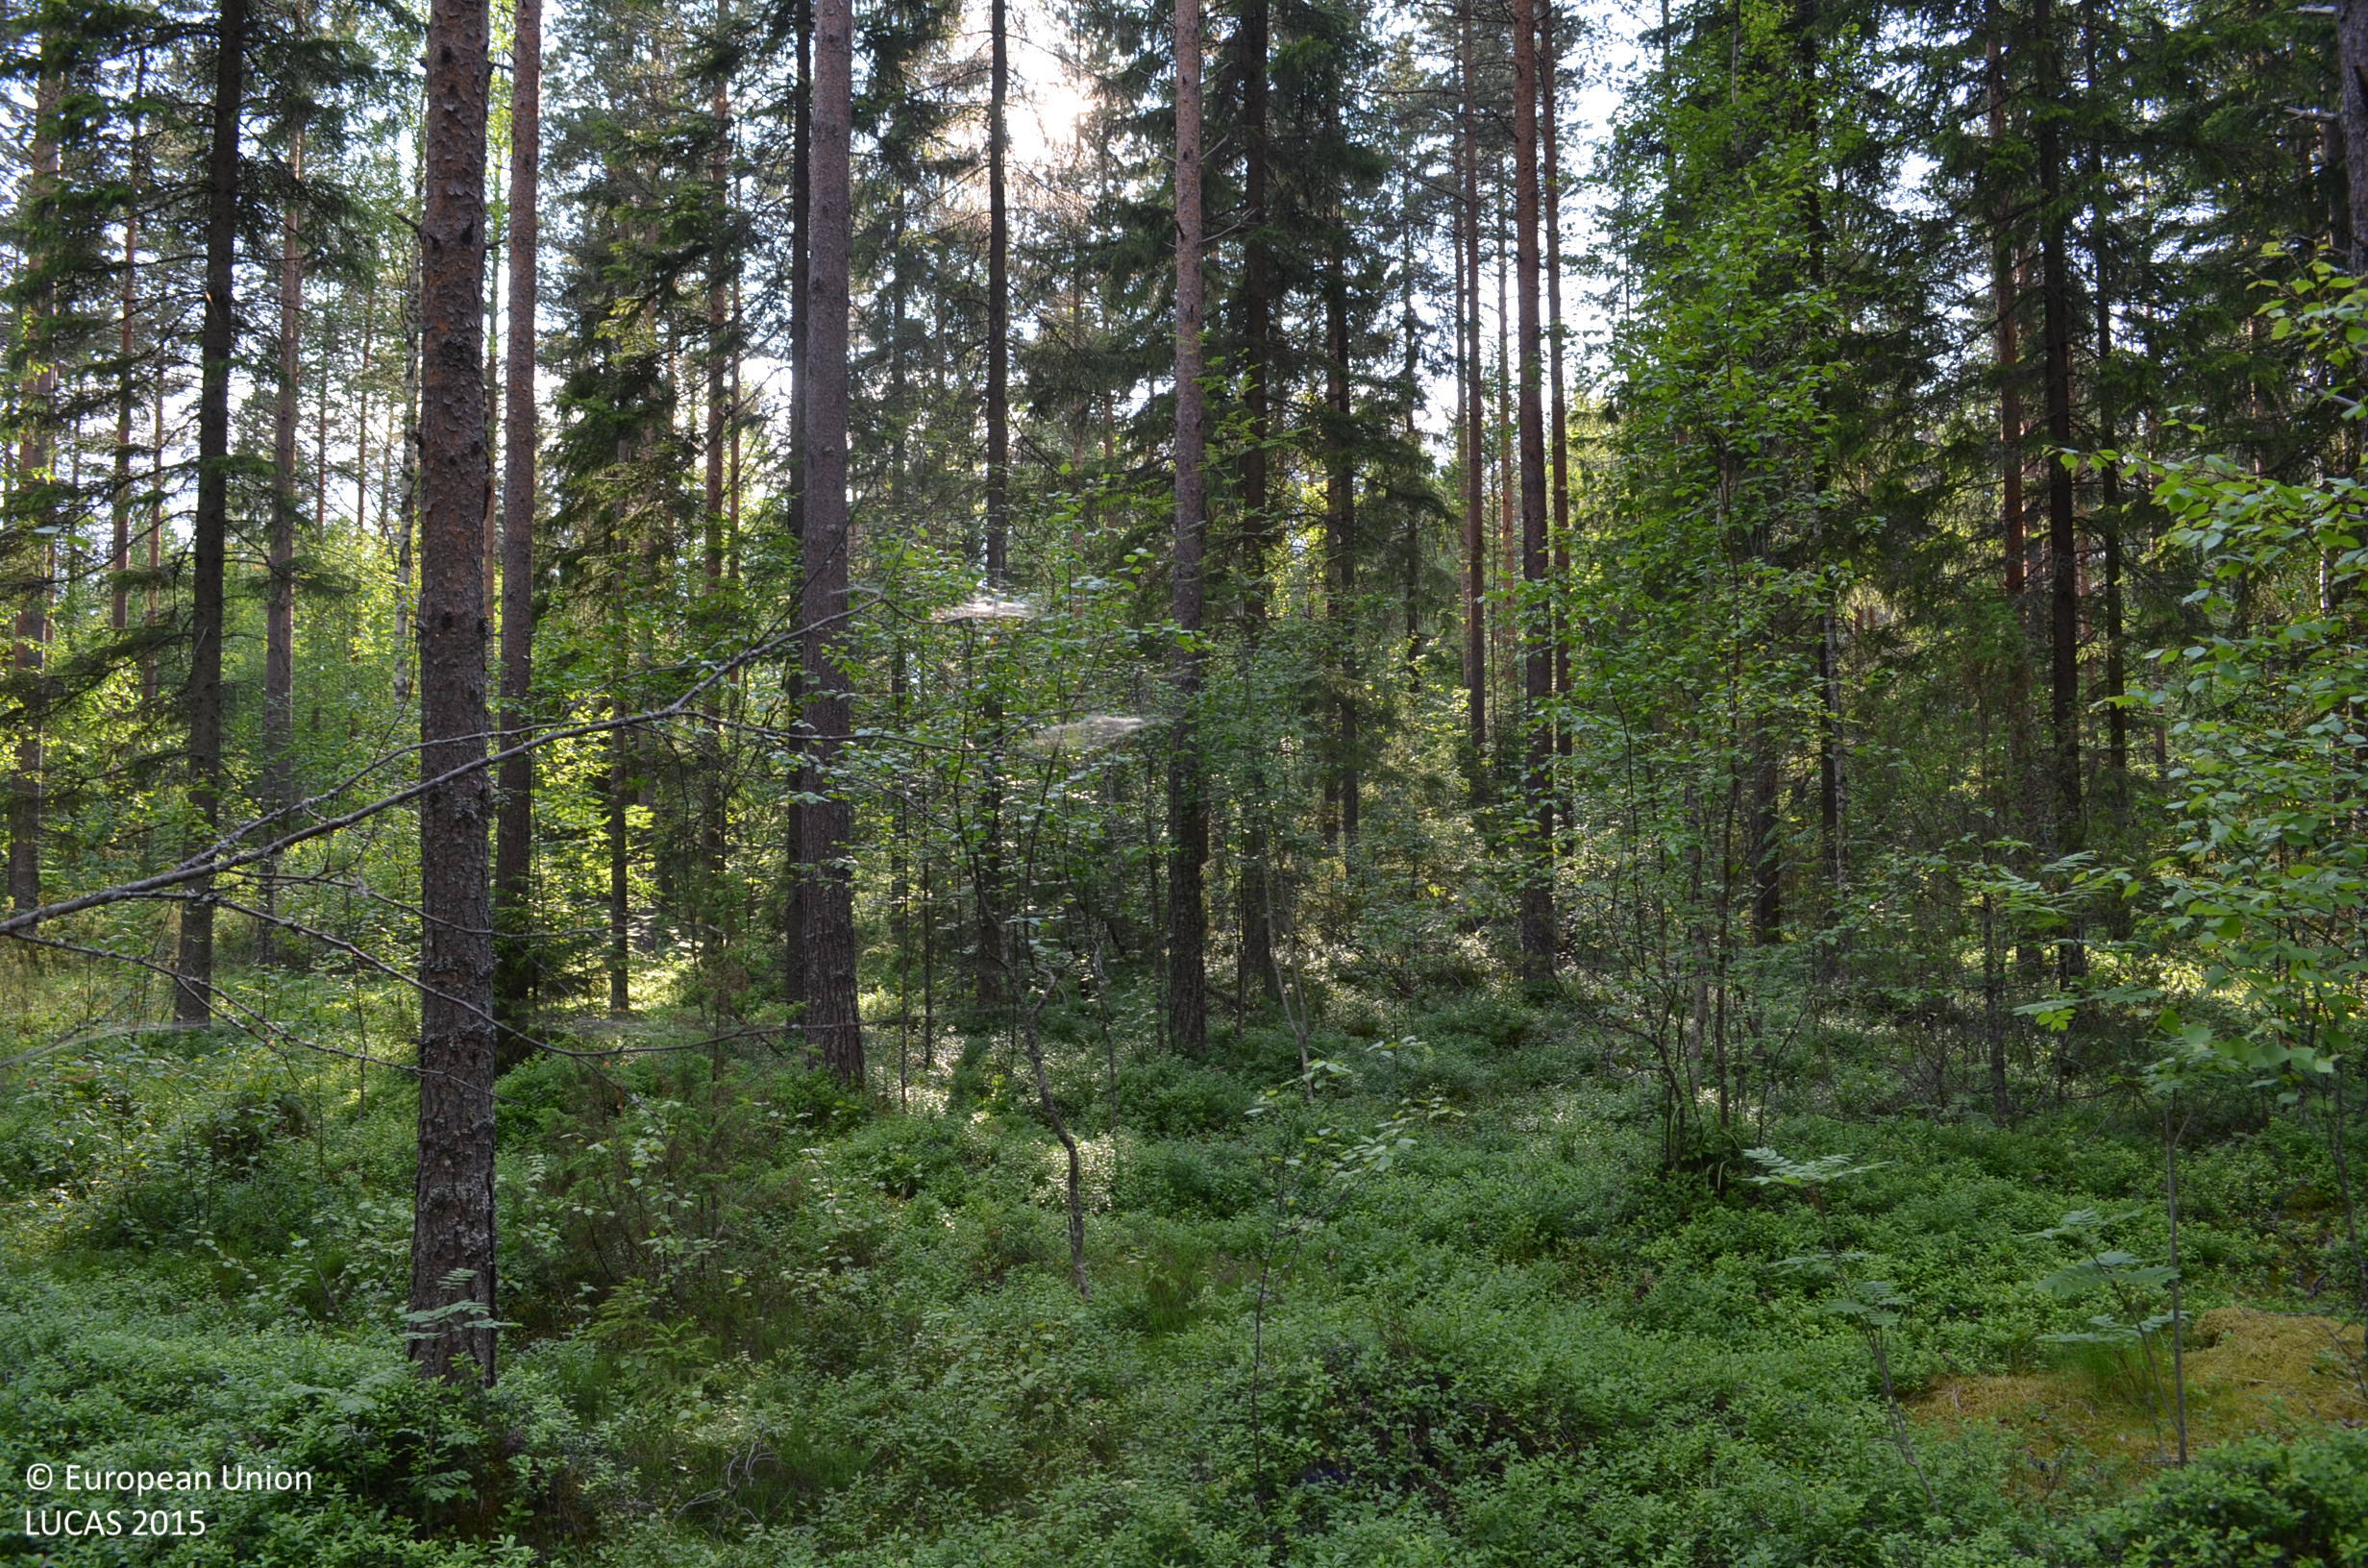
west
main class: Woodland
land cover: Pine dominated coniferous woodland
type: boreal forest
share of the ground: > 75 %
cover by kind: coniferous forest trees 70 %, shrubs 25 %, broadleaved forest trees 5 %
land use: Forestry
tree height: > 5 m
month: July
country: FI
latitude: 62.2825
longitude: 23.4275
